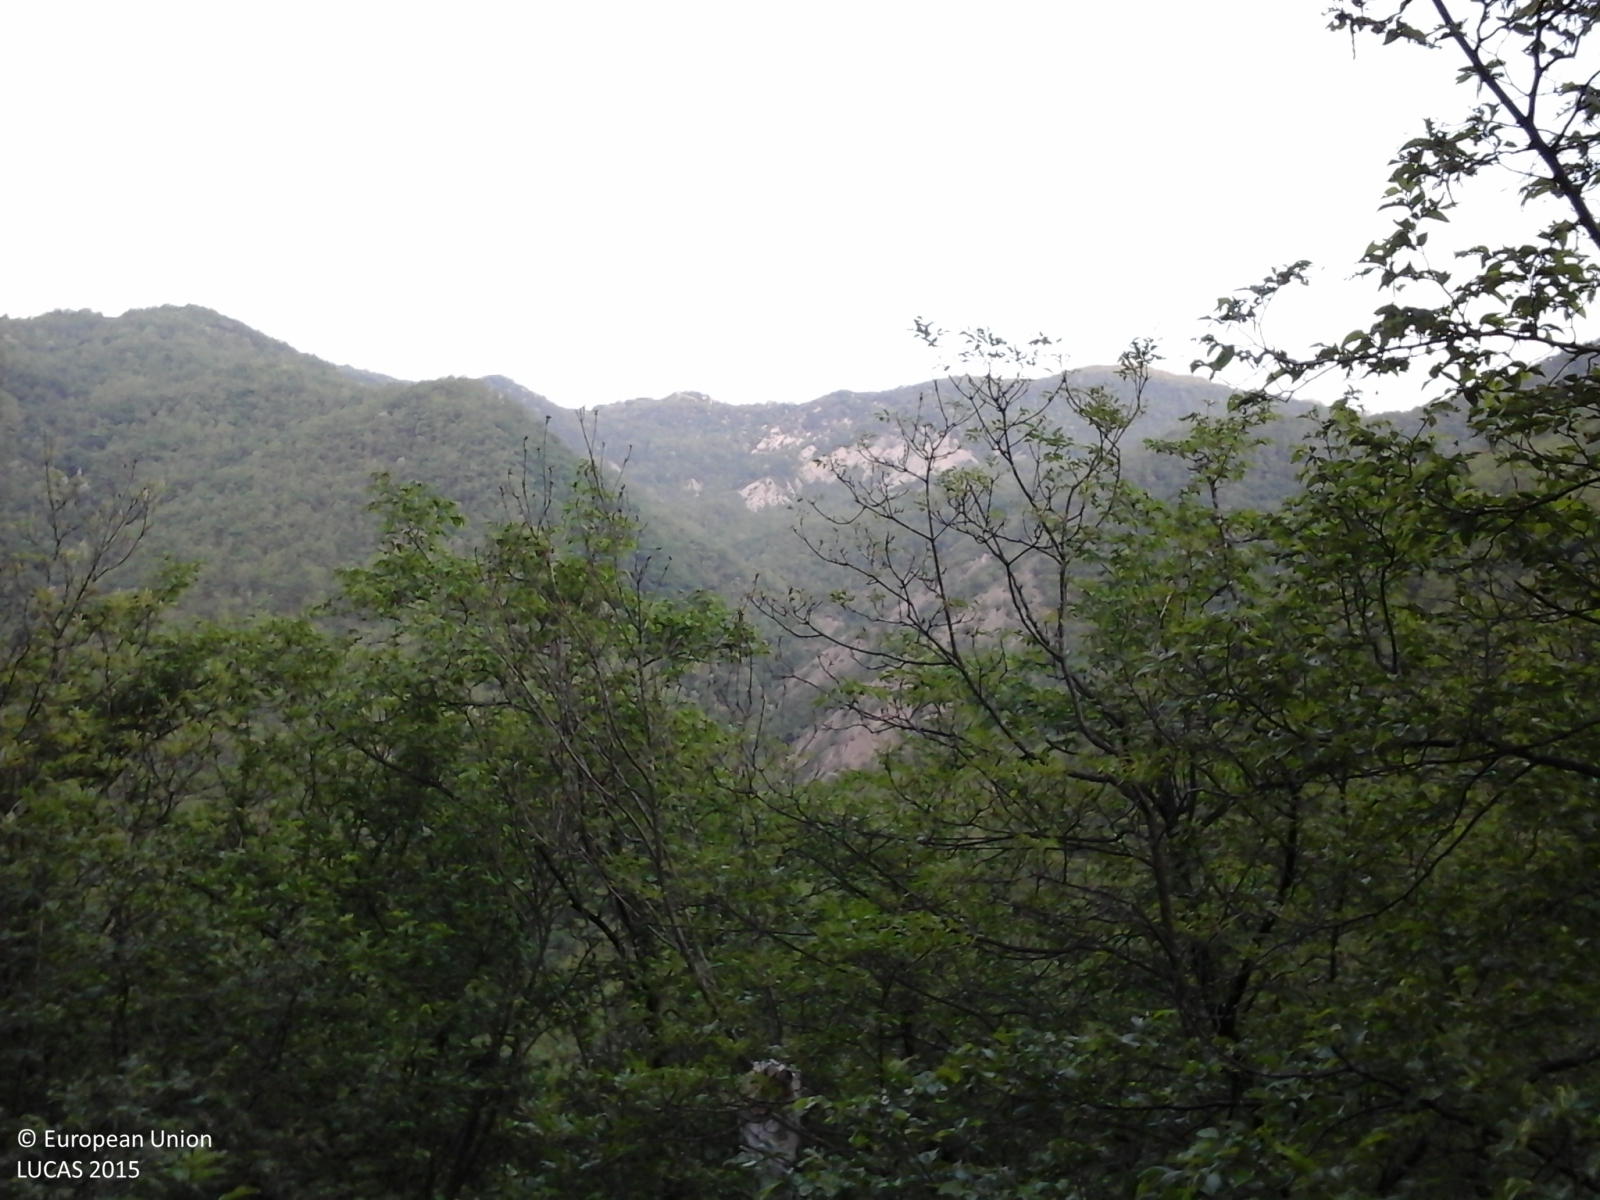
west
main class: Woodland
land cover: Broadleaved woodland
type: mesophytic deciduous forest
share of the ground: > 75 %
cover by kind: broadleaved forest trees 100 %
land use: Forestry
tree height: > 5 m
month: May
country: IT
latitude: 44.7274
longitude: 9.3826
